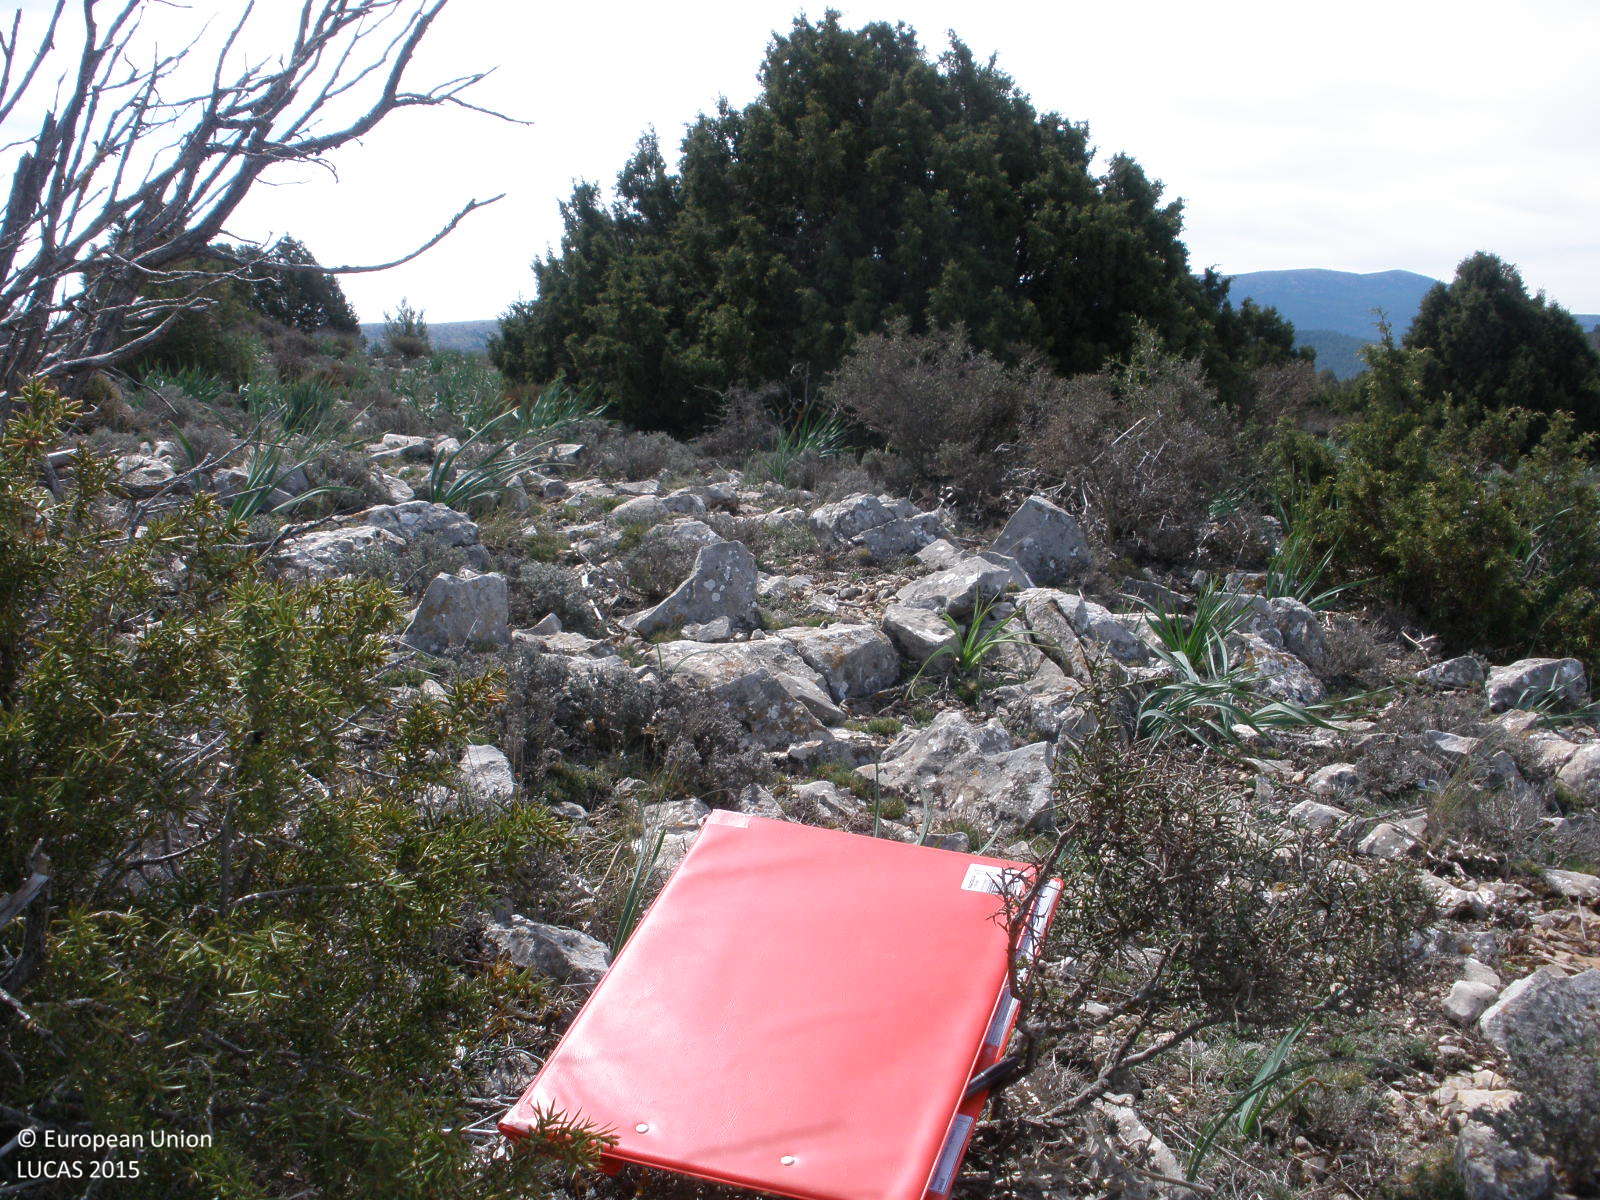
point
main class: Woodland
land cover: Other coniferous woodland
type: coniferous forest of the mediterranean region
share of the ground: 10 - 25 %
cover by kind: consolidated bare surface 45 %, shrubs 20 %, herbaceous plants 20 %, coniferous forest trees 15 %
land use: Semi-natural and natural areas not in use
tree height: < 5 m
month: April
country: ES
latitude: 40.2256
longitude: -1.0441
